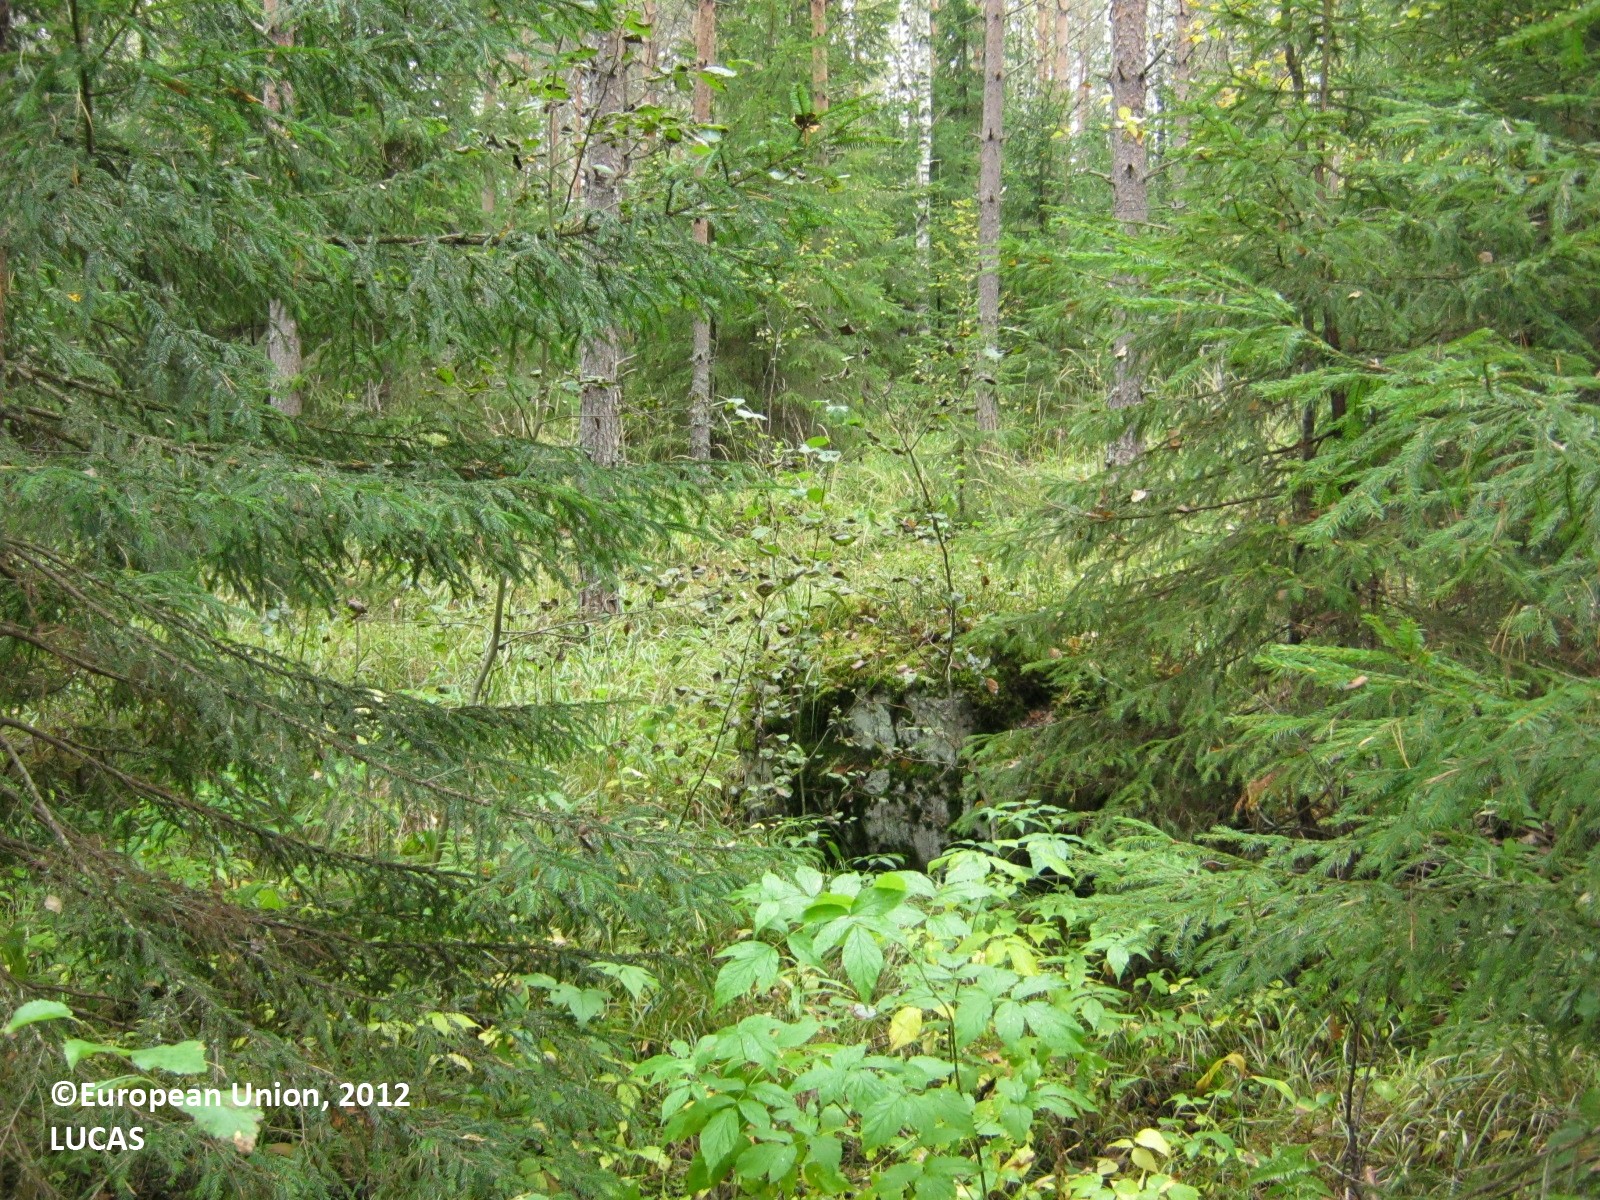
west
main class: Woodland
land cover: Other coniferous woodland
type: boreal forest
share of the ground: 50 - 75 %
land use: Forestry
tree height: > 5 m
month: September
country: FI
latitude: 60.8154
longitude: 27.6350
